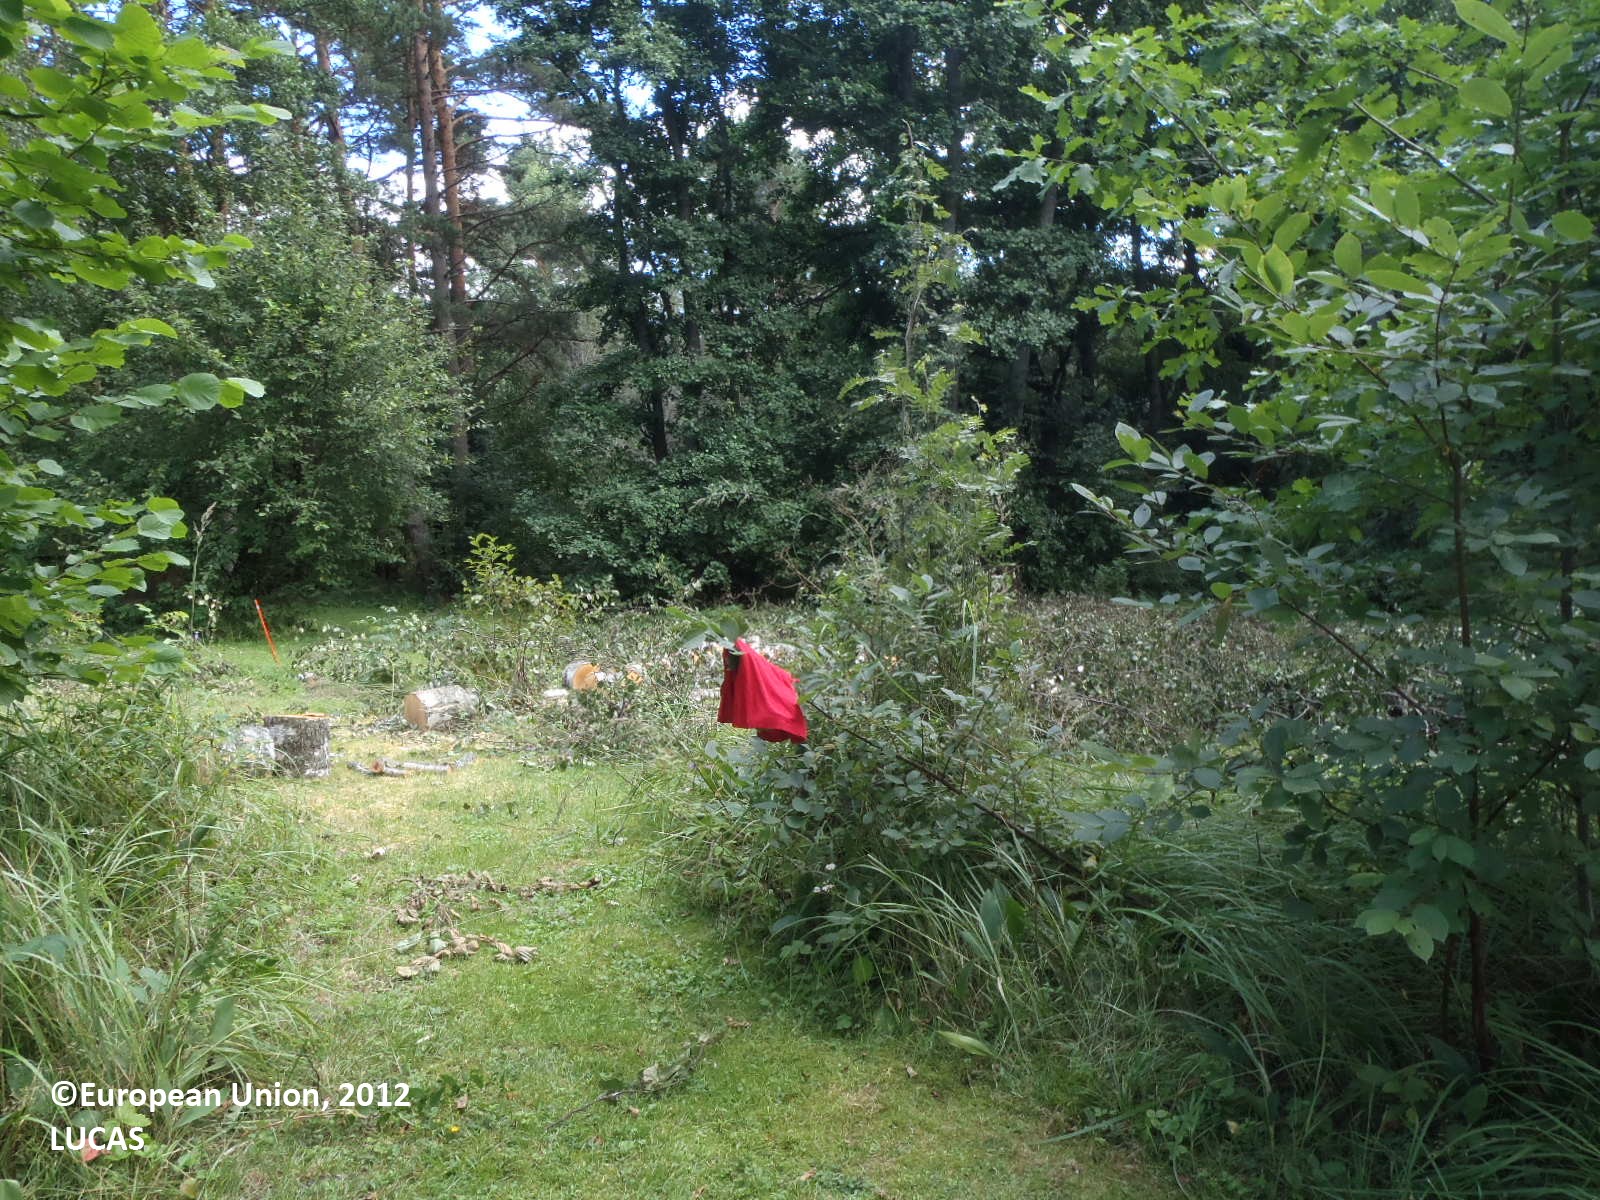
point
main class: Woodland
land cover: Pine dominated mixed woodland
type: boreal forest
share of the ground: 25 - 50 %
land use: Residential
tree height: > 5 m
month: August
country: FI
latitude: 60.1552
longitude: 21.8264
